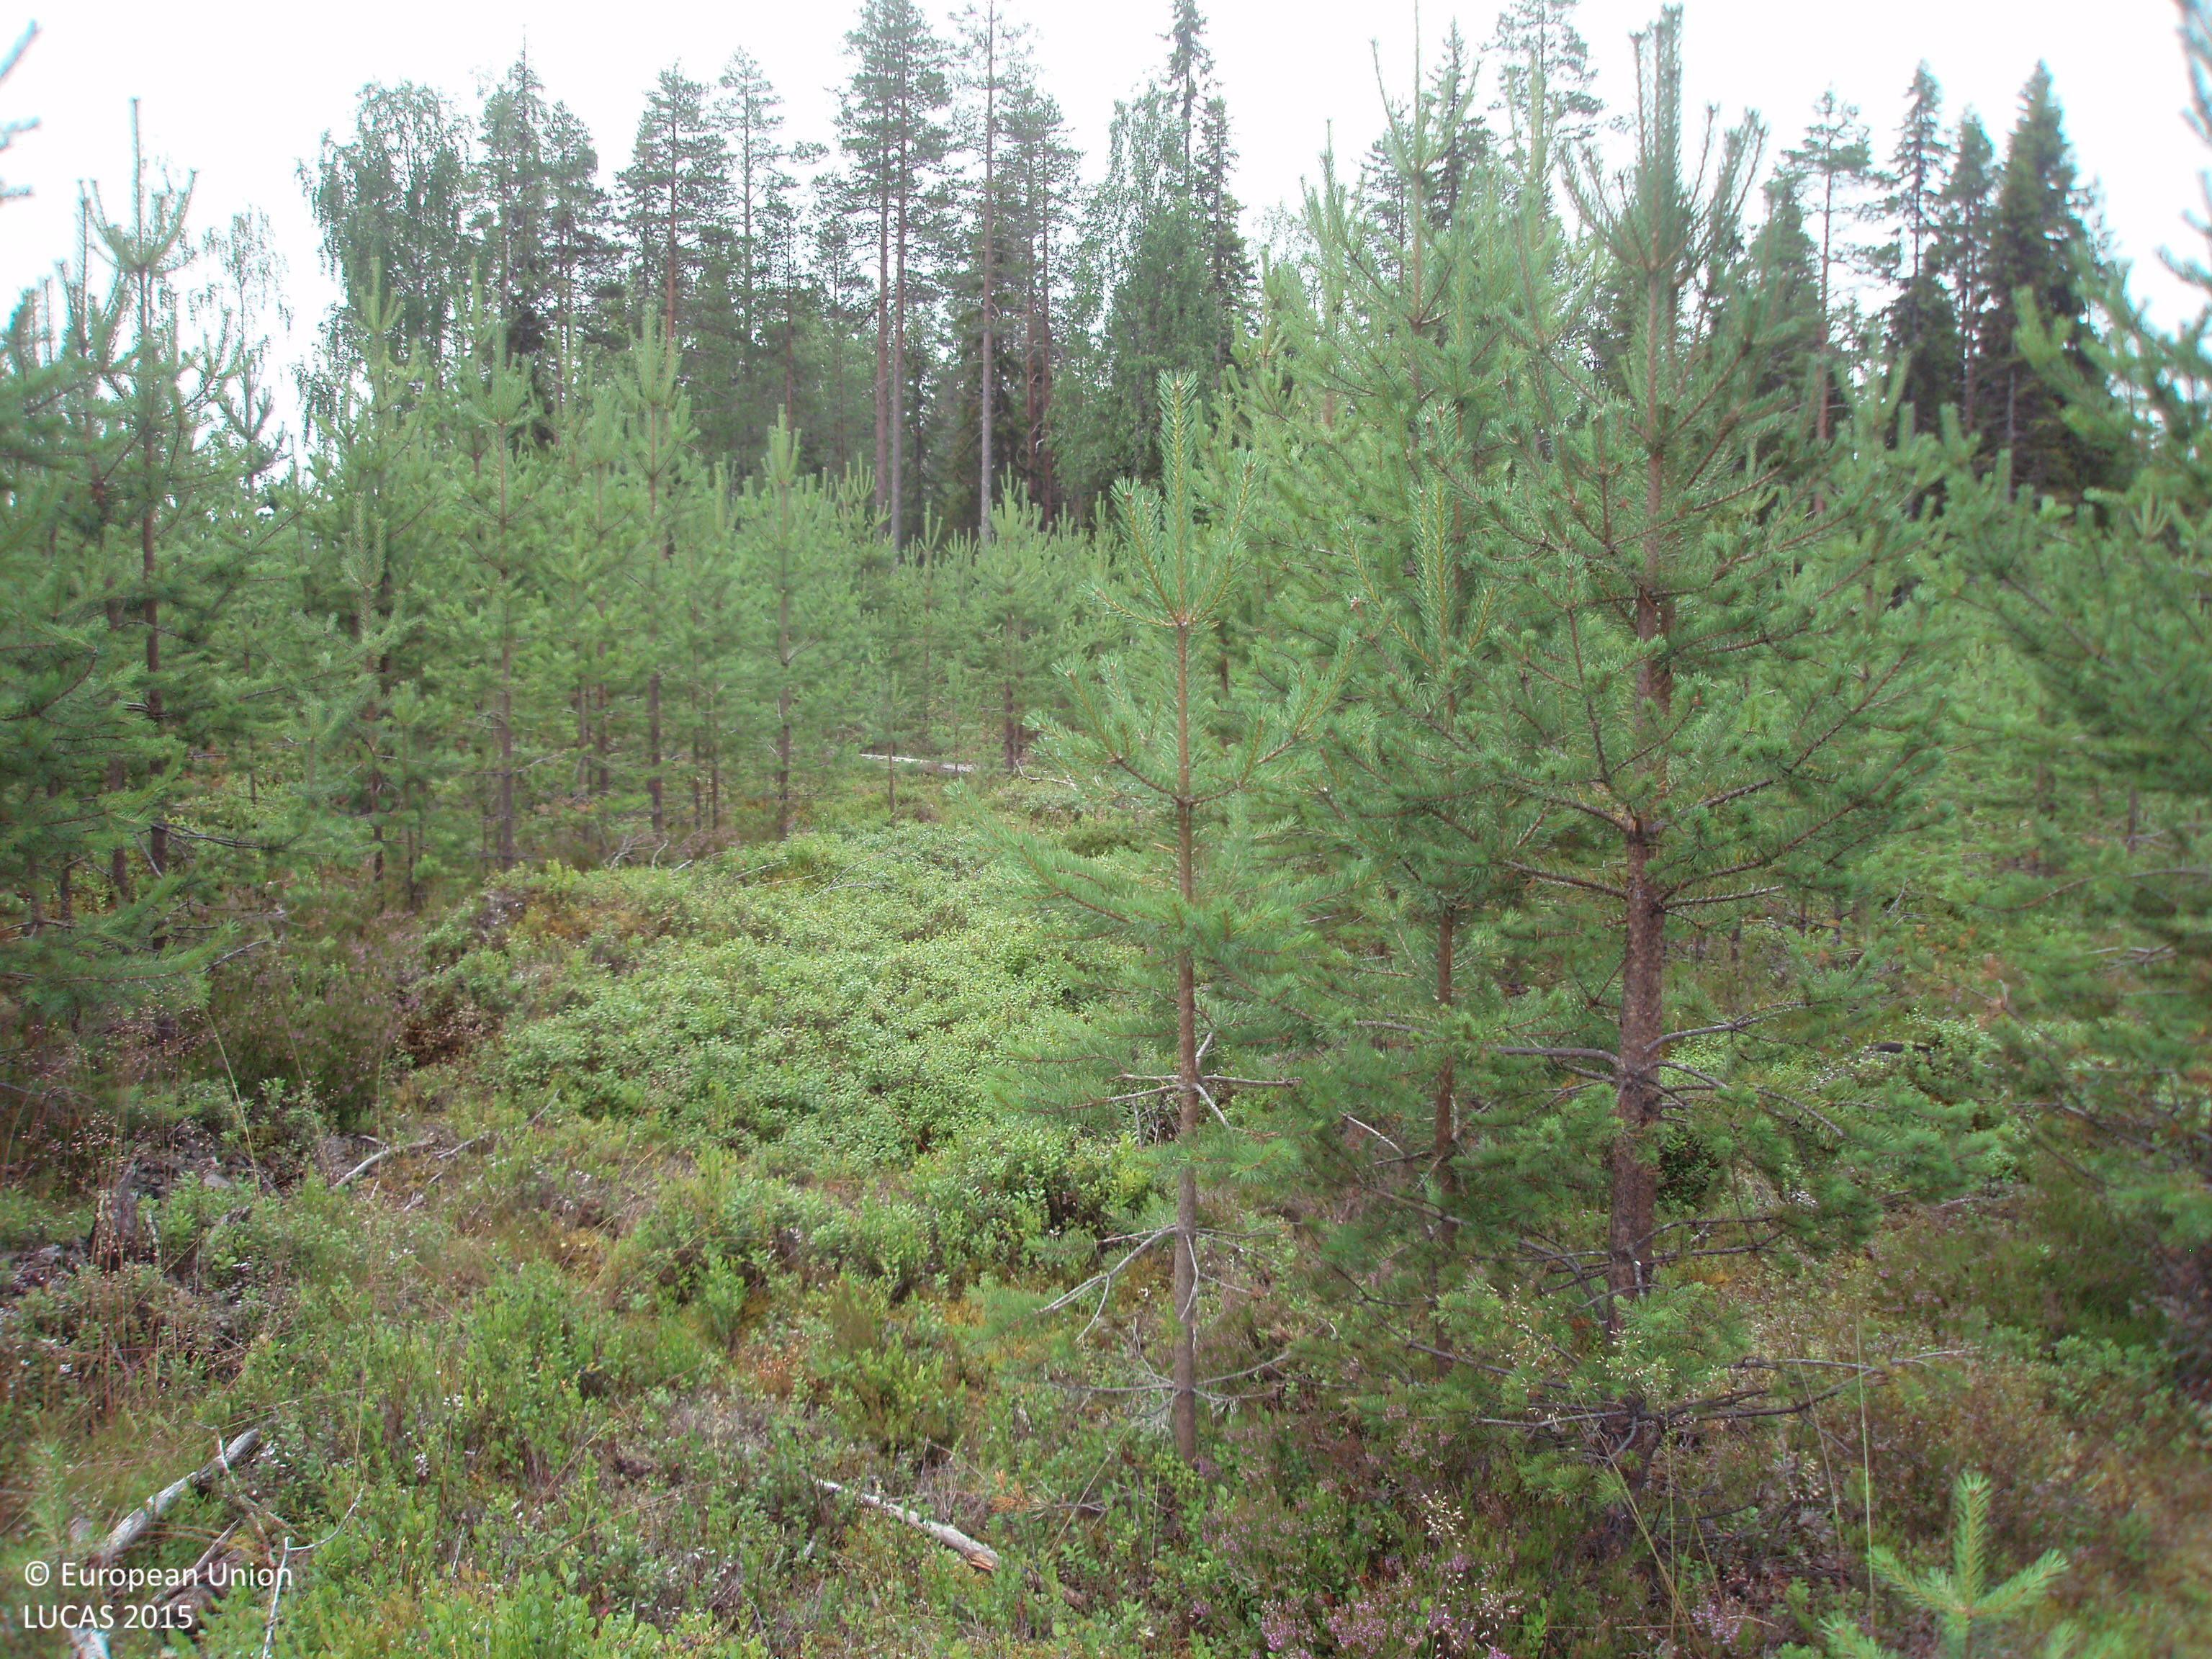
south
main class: Woodland
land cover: Pine dominated coniferous woodland
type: boreal forest
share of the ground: 25 - 50 %
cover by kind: shrubs 65 %, coniferous forest trees 35 %
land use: Forestry
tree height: < 5 m
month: August
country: FI
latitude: 65.4930
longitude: 27.0329
